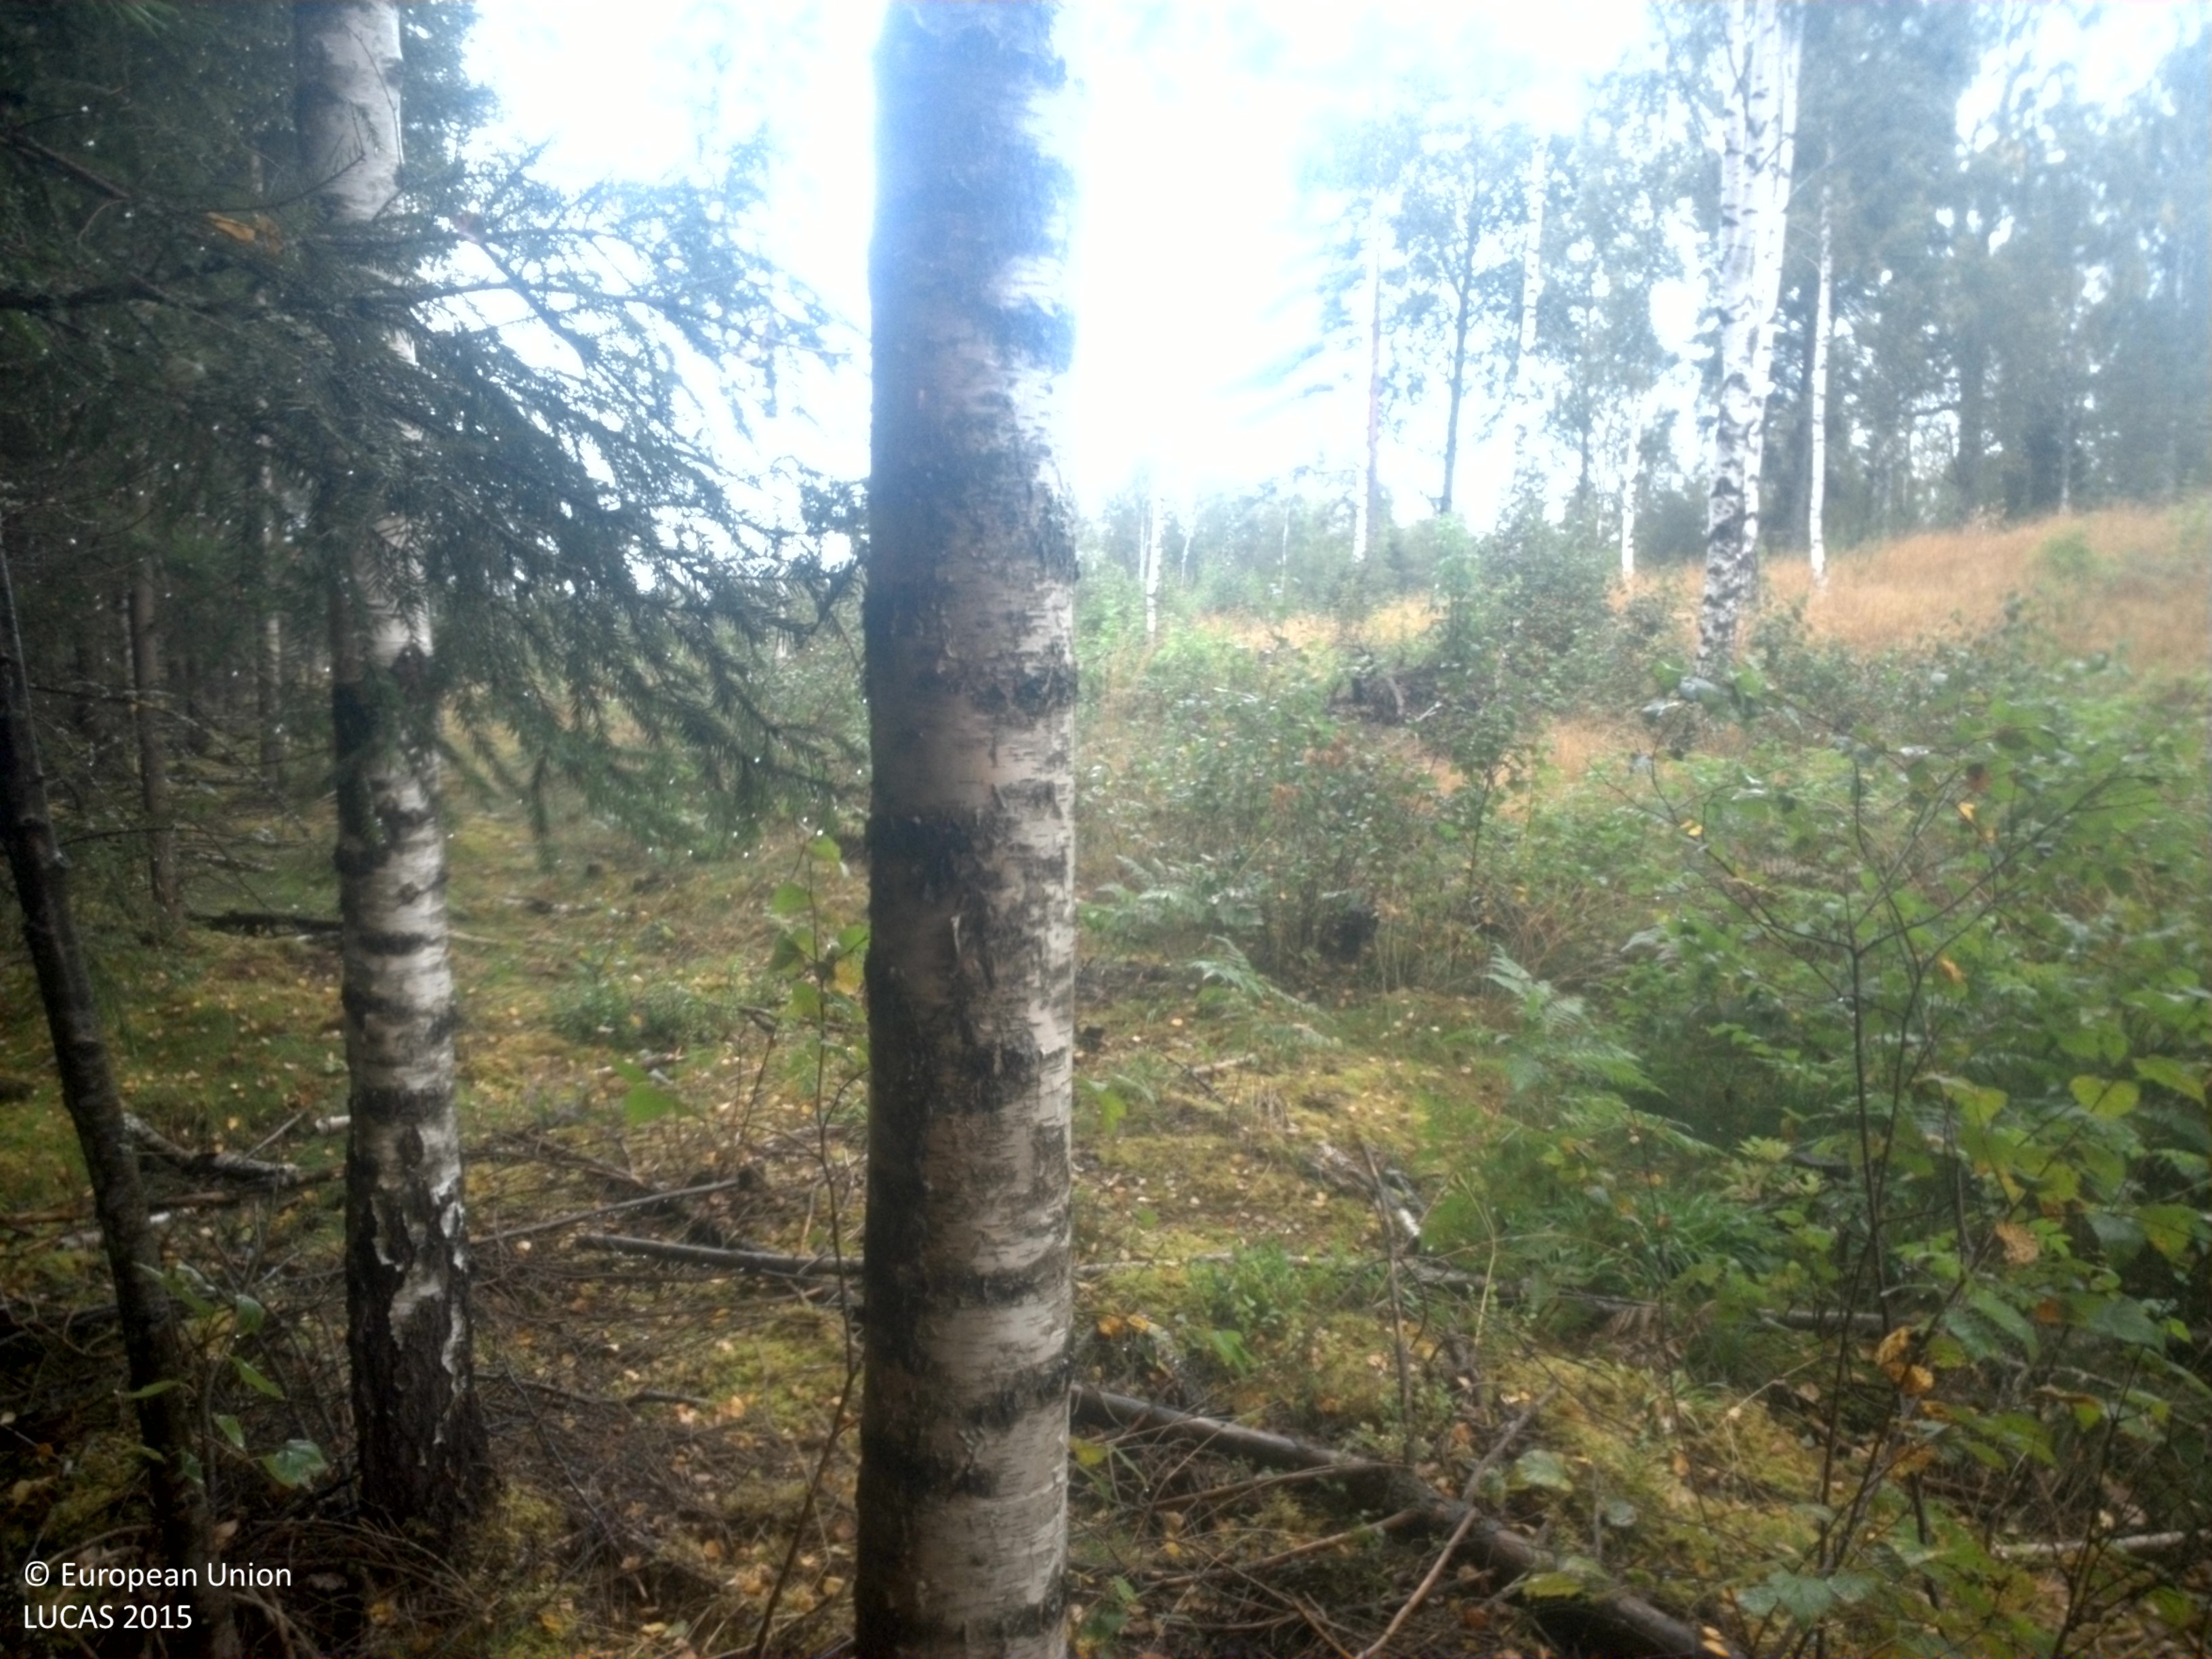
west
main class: Woodland
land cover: Spruce dominated mixed woodland
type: boreal forest
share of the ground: > 75 %
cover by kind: coniferous forest trees 55 %, broadleaved forest trees 30 %, lichens and mosses 5 %
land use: Forestry
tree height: > 5 m
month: August
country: SE
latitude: 59.6286
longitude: 15.7892
